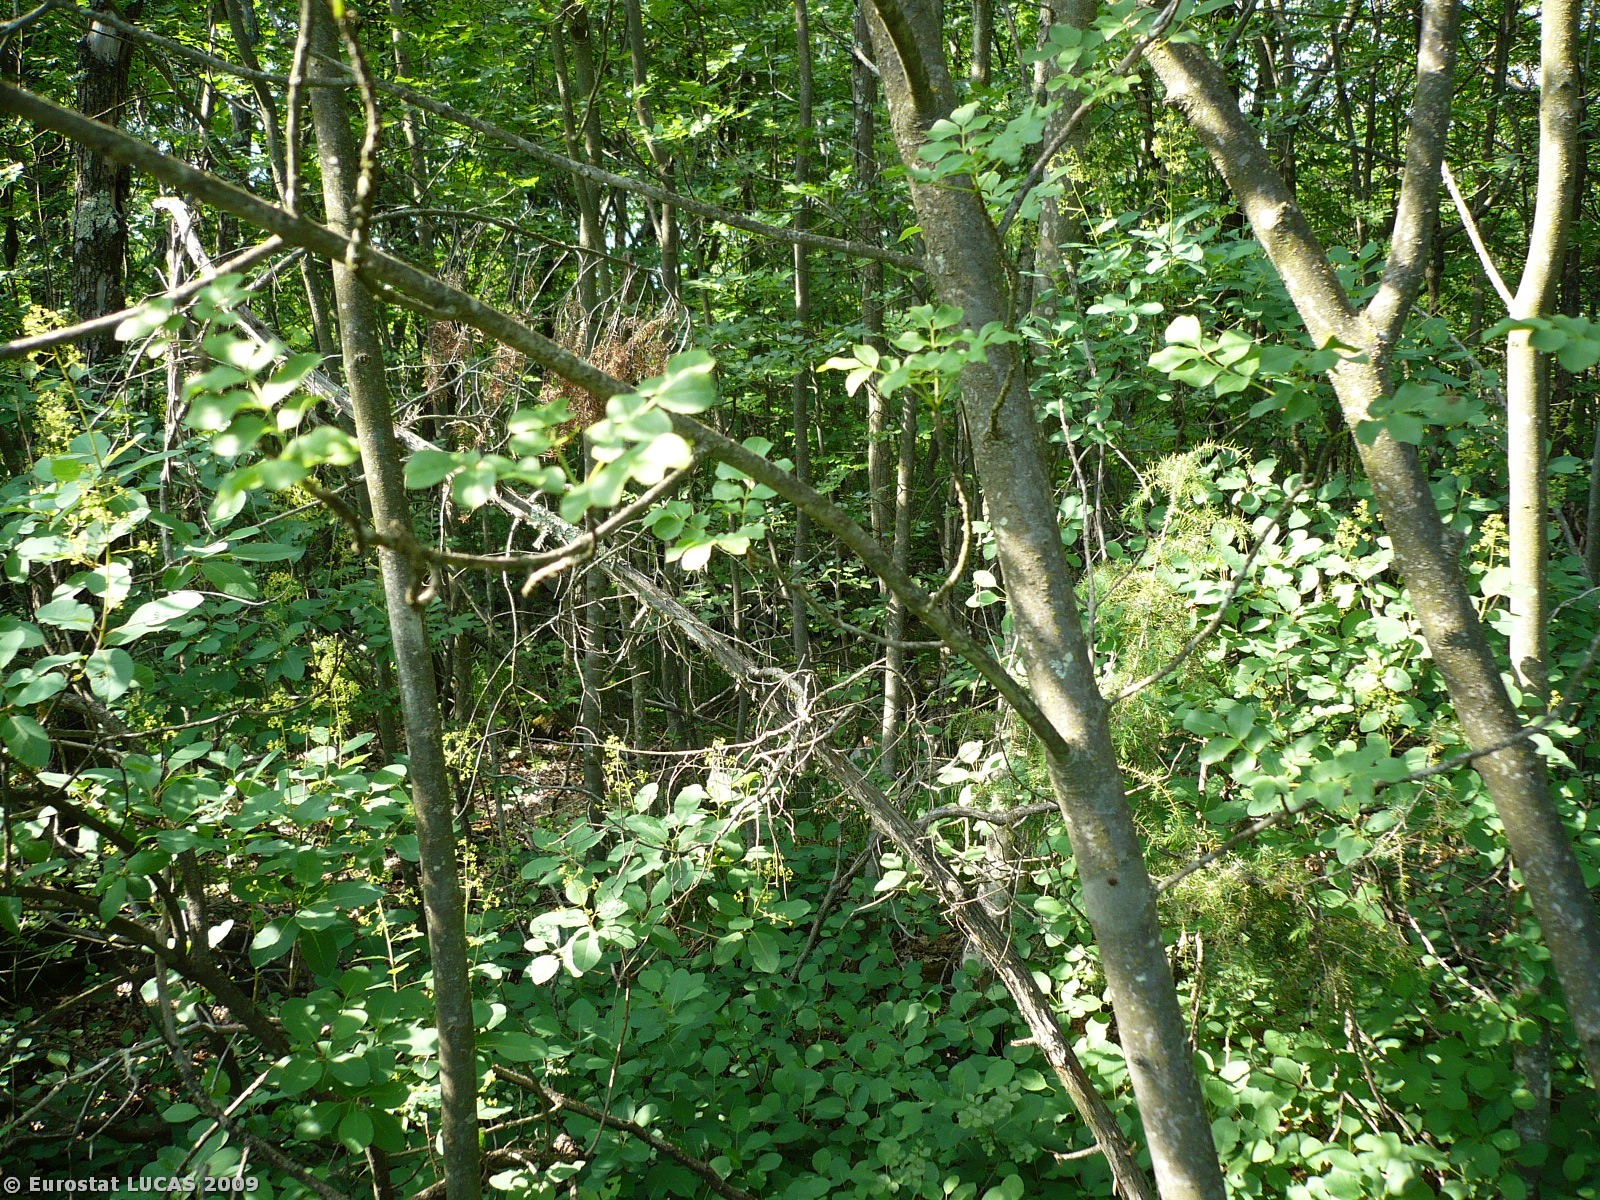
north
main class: Woodland
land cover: Broadleaved woodland
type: thermophilous deciduous forest
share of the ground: > 75 %
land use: Unused
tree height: > 5 m
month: May
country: SI
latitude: 45.8376
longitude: 13.6653
